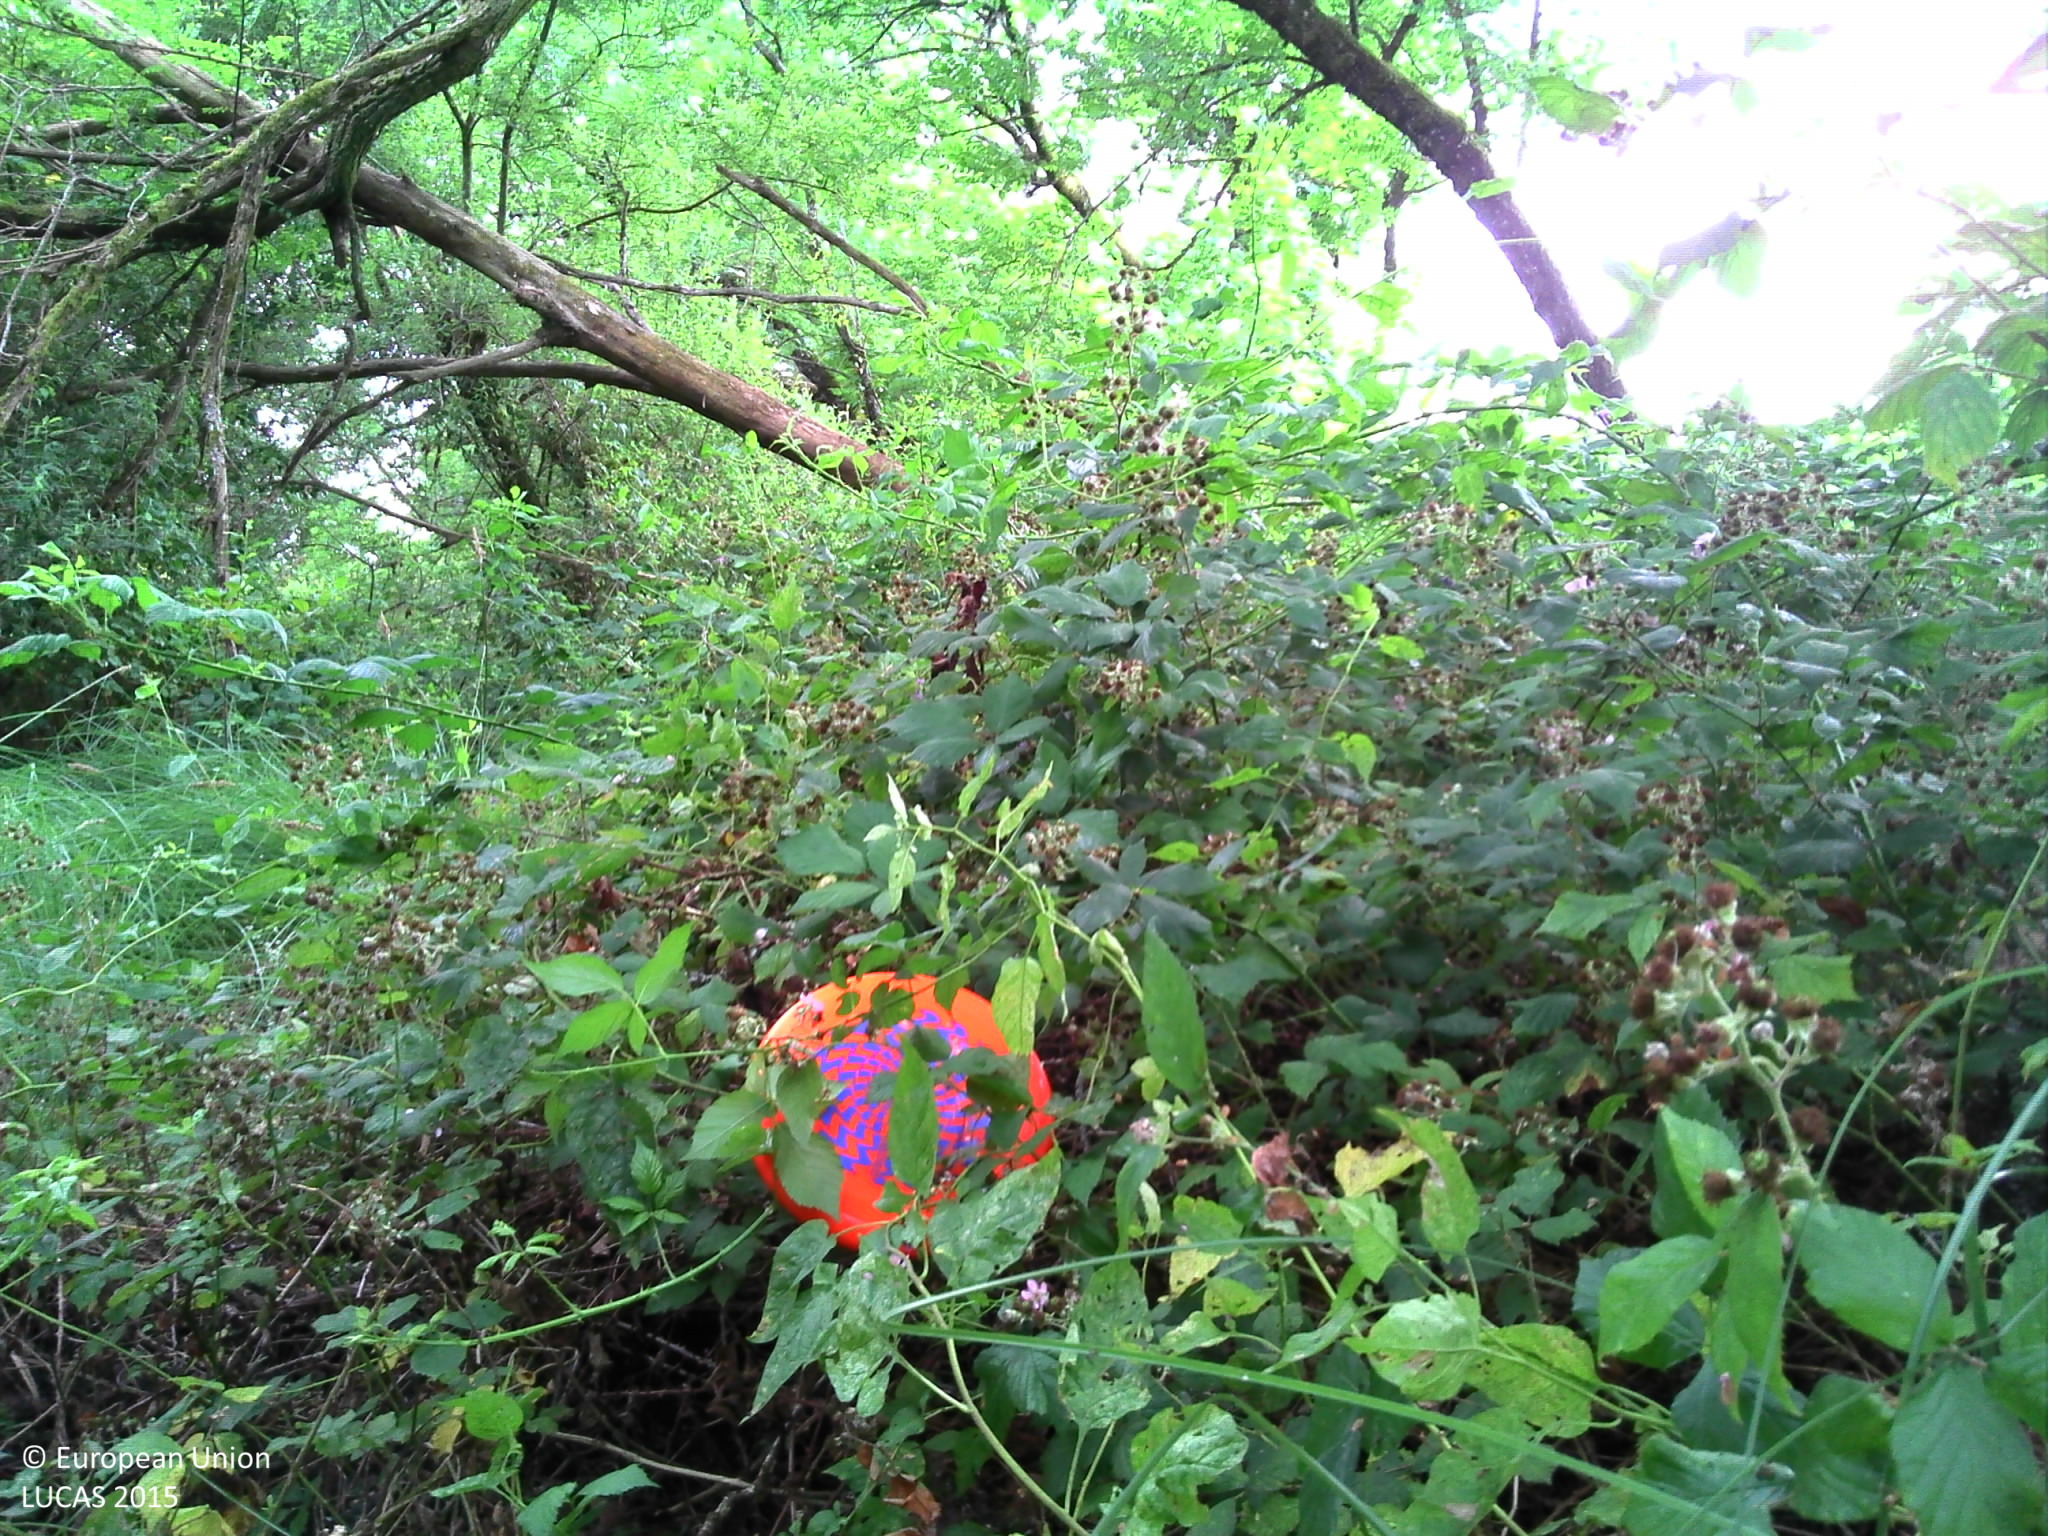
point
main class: Woodland
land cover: Broadleaved woodland
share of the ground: 25 - 50 %
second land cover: Spontaneously vegetated surfaces
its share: 50 - 75 %
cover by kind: herbaceous plants 65 %, broadleaved forest trees 25 %
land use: Agriculture (excluding fallow land and kitchen gardens)
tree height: < 5 m
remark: Temporary flooded
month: July
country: FR
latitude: 45.7096
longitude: 0.7003
